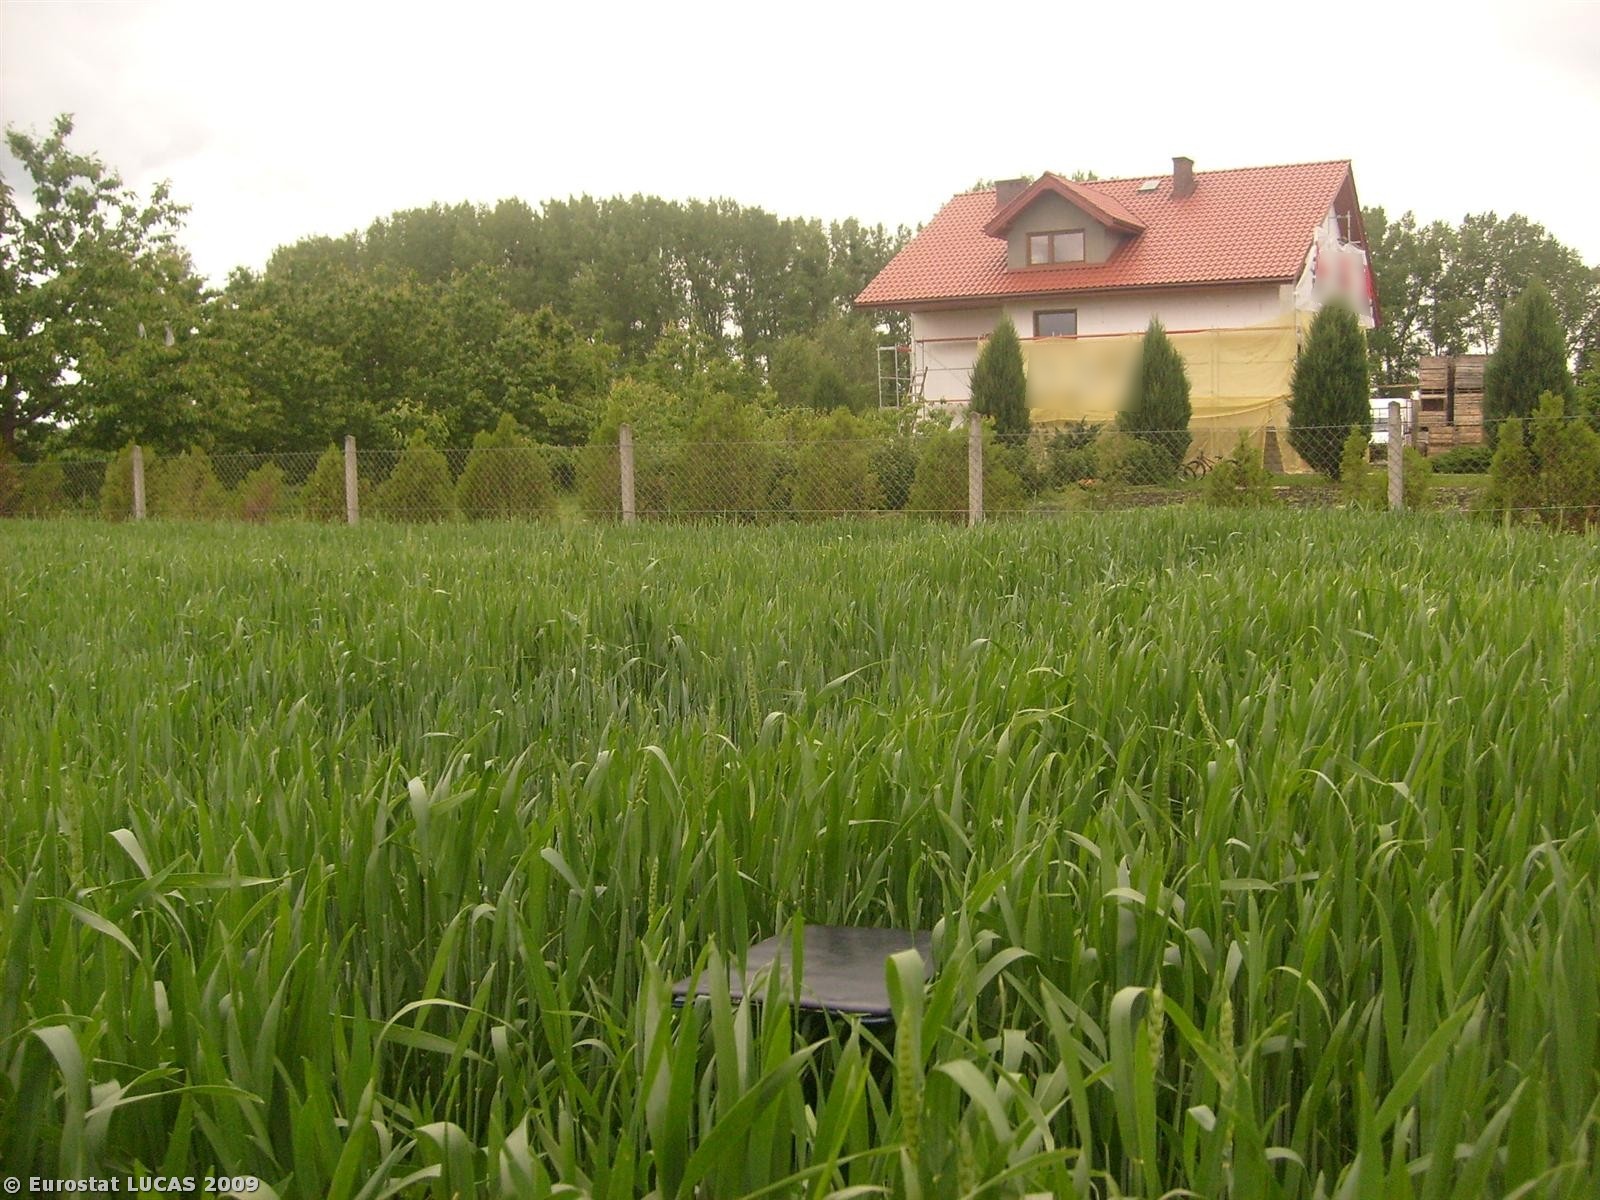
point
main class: Cropland
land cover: Common wheat
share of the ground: > 75 %
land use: Agriculture (excluding fallow land and kitchen gardens)
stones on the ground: < 10 %
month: June
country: PL
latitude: 50.7884
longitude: 23.8940
